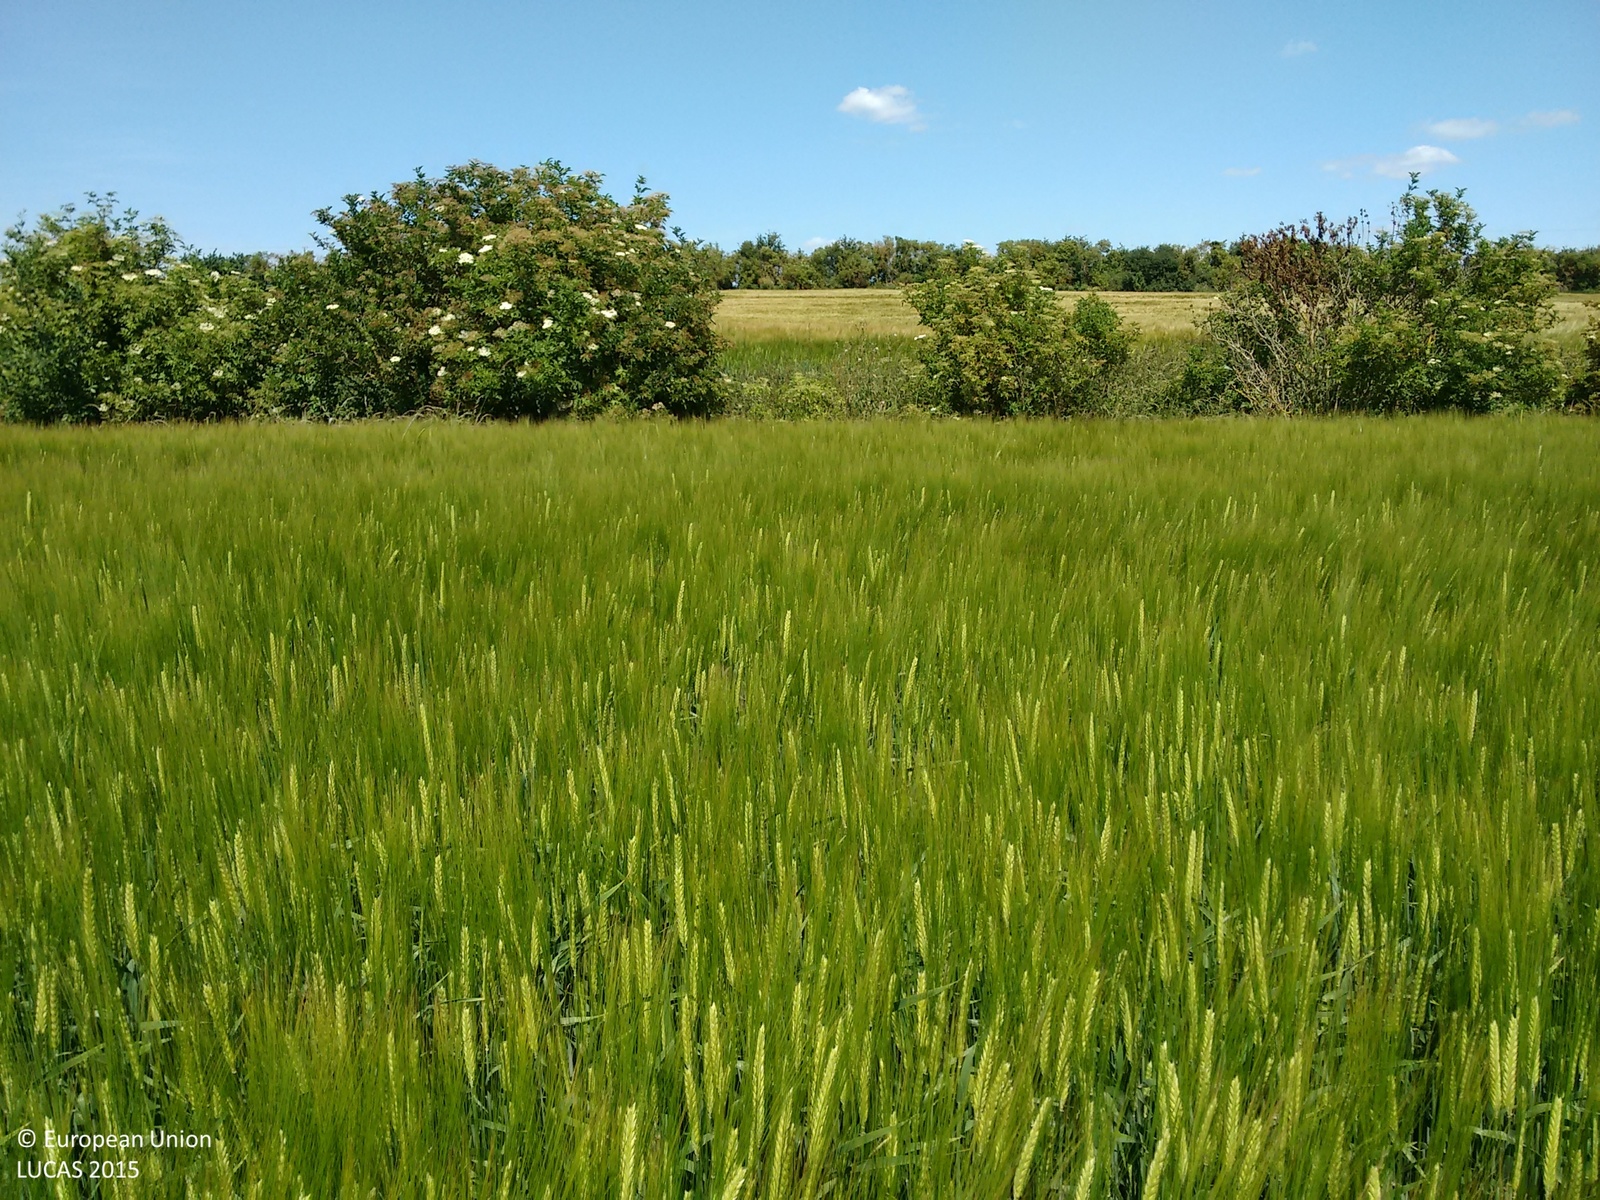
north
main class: Cropland
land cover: Barley
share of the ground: > 75 %
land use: Agriculture (excluding fallow land and kitchen gardens)
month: July
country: GB
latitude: 51.9987
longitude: -1.3075
